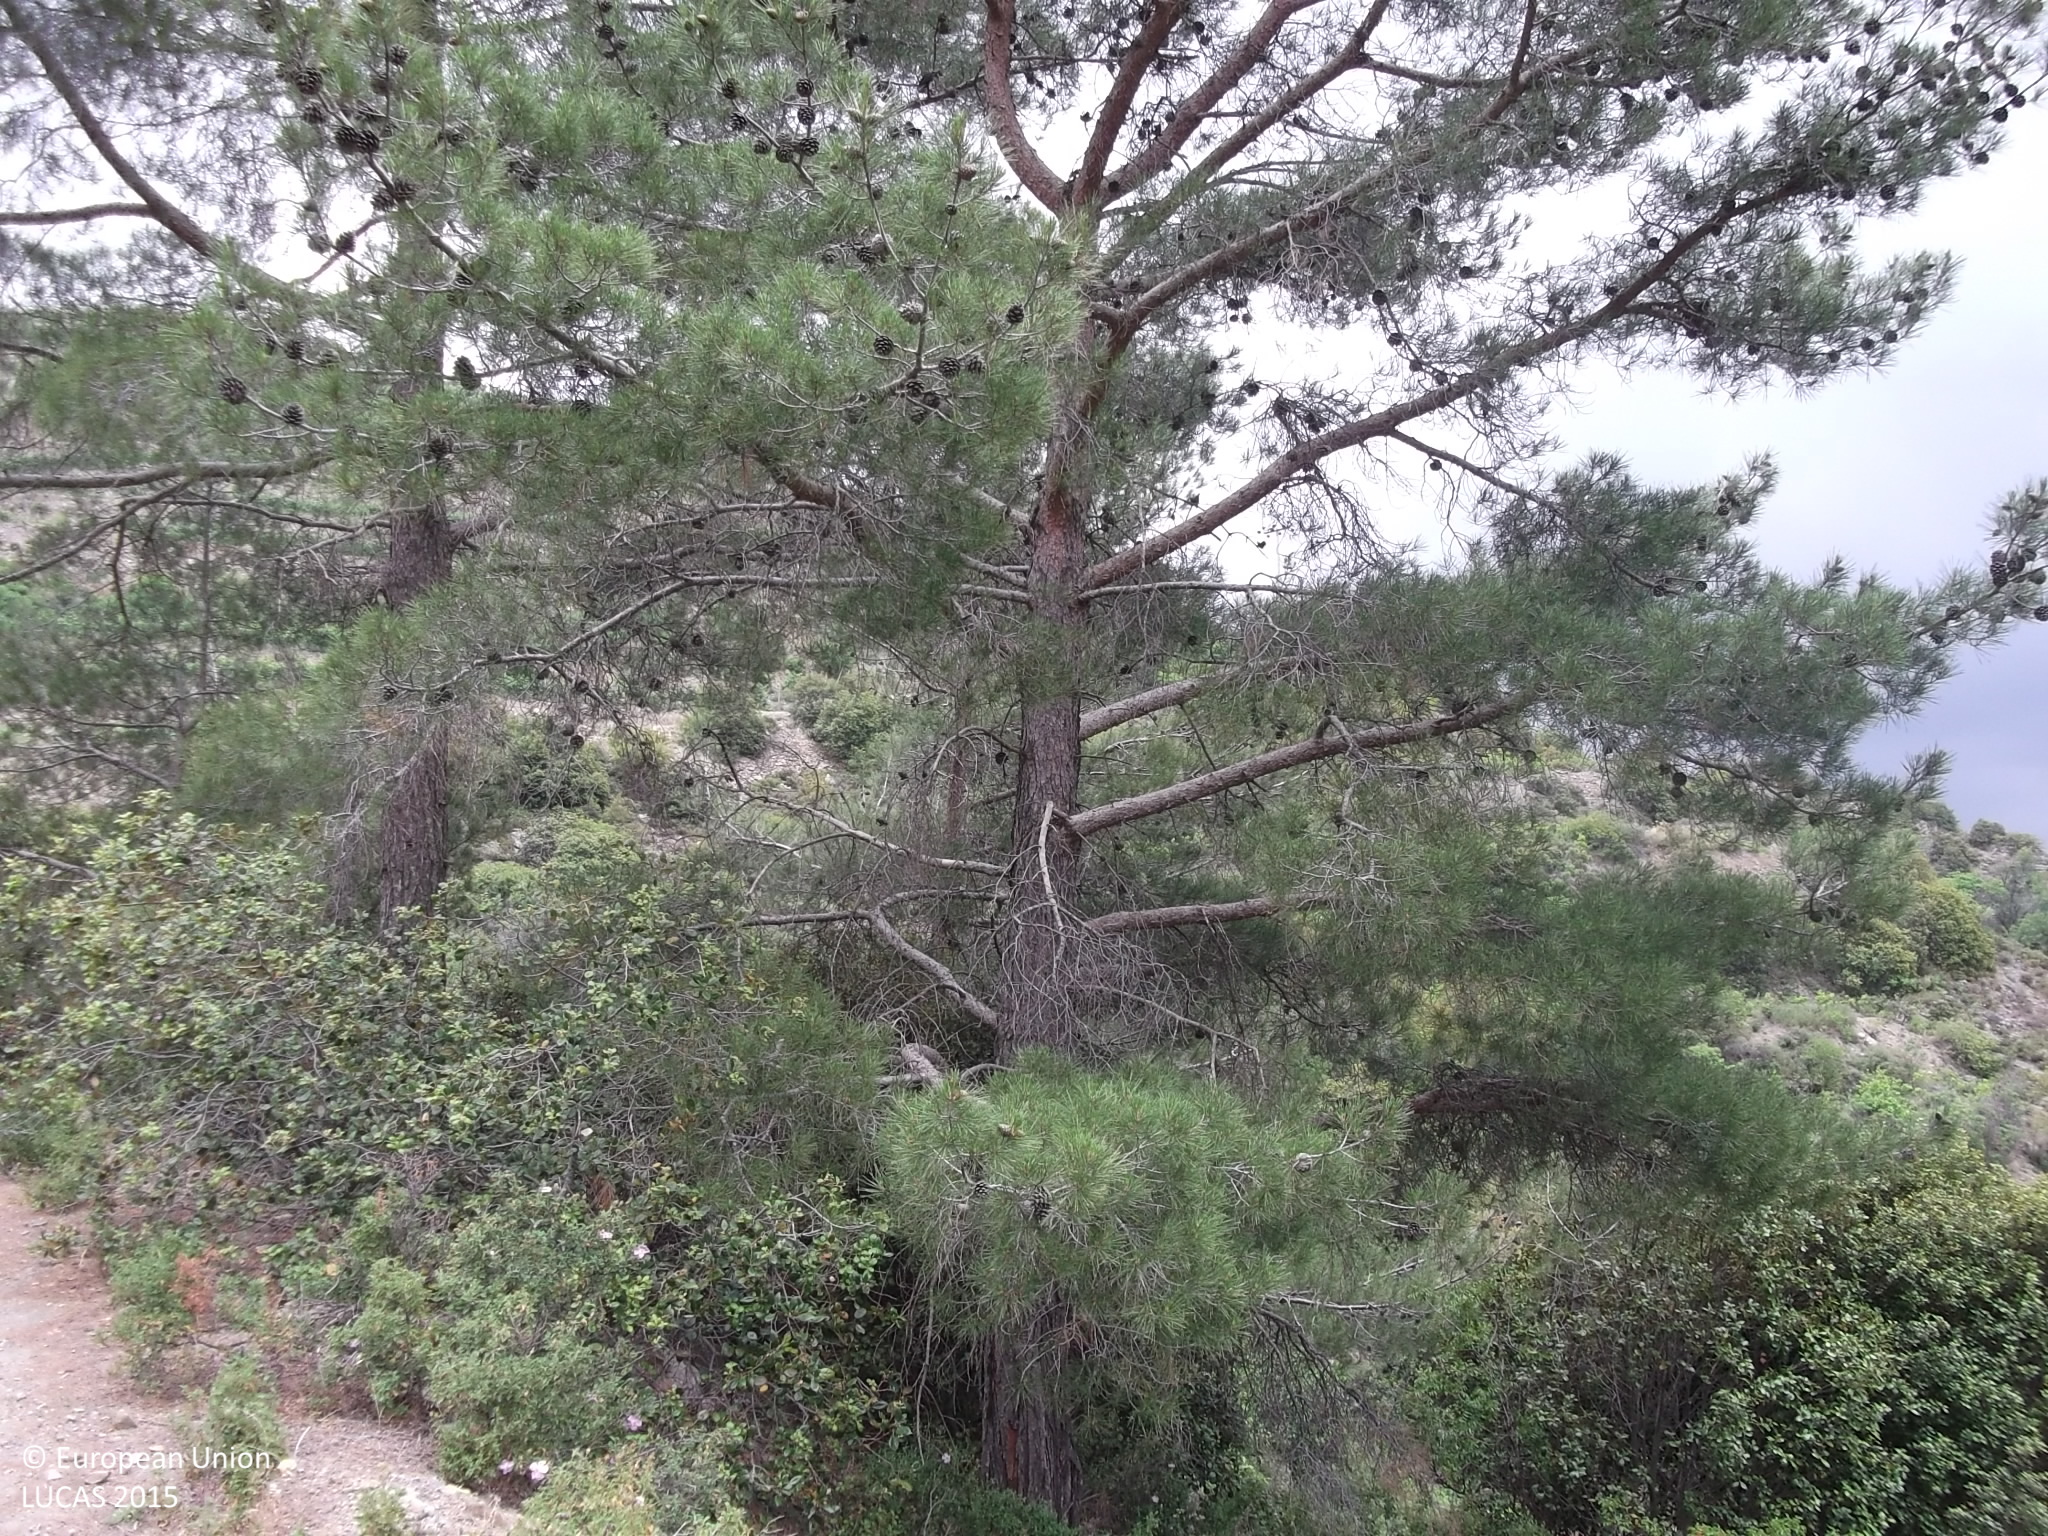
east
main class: Woodland
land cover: Pine dominated mixed woodland
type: coniferous forest of the mediterranean region
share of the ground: 25 - 50 %
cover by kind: coniferous forest trees 40 %, shrubs 35 %, broadleaved forest trees 15 %, unconsolidated bare surface 10 %
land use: Semi-natural and natural areas not in use
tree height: > 5 m
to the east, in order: Pine dominated mixed woodland; Shrubland without tree cover; Pine dominated mixed woodland; Nuts trees; Tracks; Shrubland with sparse tree cover; Tracks; Apple fruit; Cherry fruit; Tracks; Vineyards; Dry stone walls; Vineyards; Dry stone walls; Vineyards; Tracks; Vineyards; Dry stone walls; Vineyards; Tracks; Vineyards; Dry stone walls; Vineyards; Dry stone walls; Vineyards; Spontaneously vegetated surfaces; Shrubland without tree cover; Vineyards
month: June
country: CY
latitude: 34.9490
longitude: 32.9802
